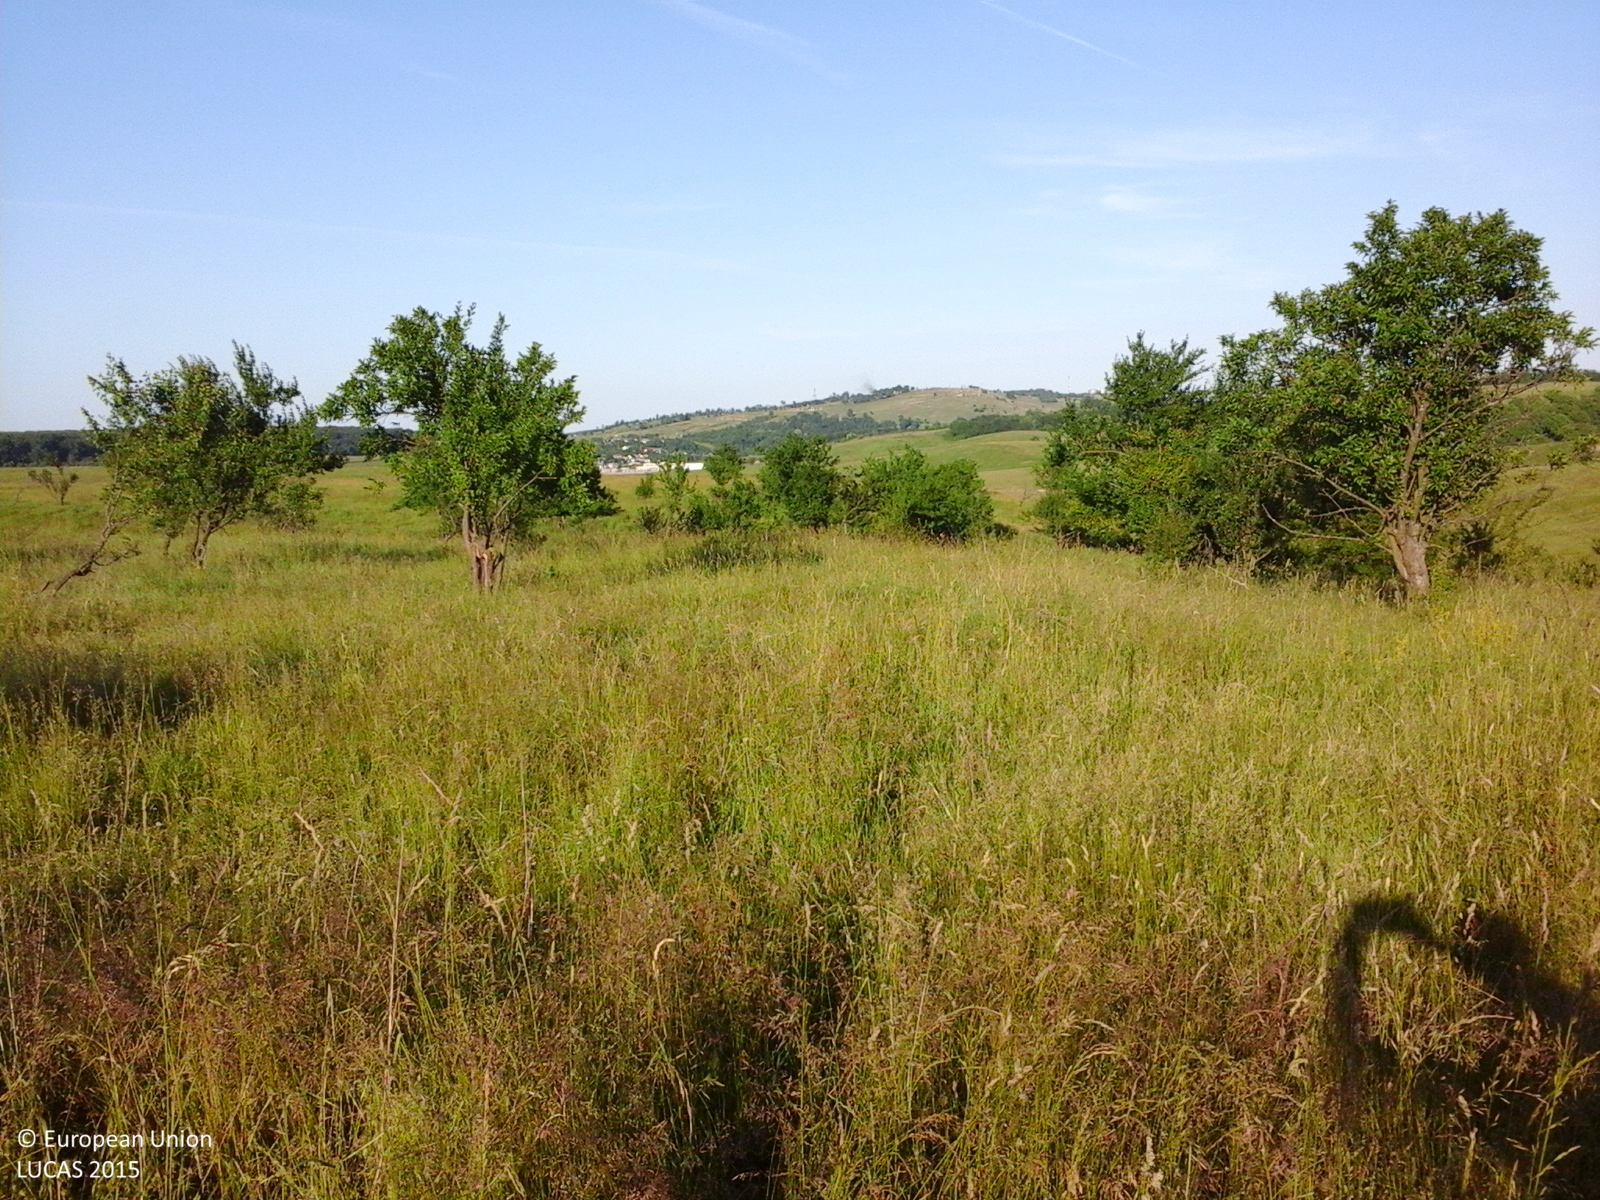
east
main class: Grassland
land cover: Grassland with sparse tree/shrub cover
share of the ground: > 75 %
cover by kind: herbaceous plants 85 %, shrubs 10 %, broadleaved forest trees 5 %
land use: Agriculture (excluding fallow land and kitchen gardens)
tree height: < 5 m
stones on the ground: < 10 %
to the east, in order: Grassland with sparse tree/shrub cover; Tracks; Grassland with sparse tree/shrub cover
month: June
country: RO
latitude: 45.0480
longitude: 25.8617
